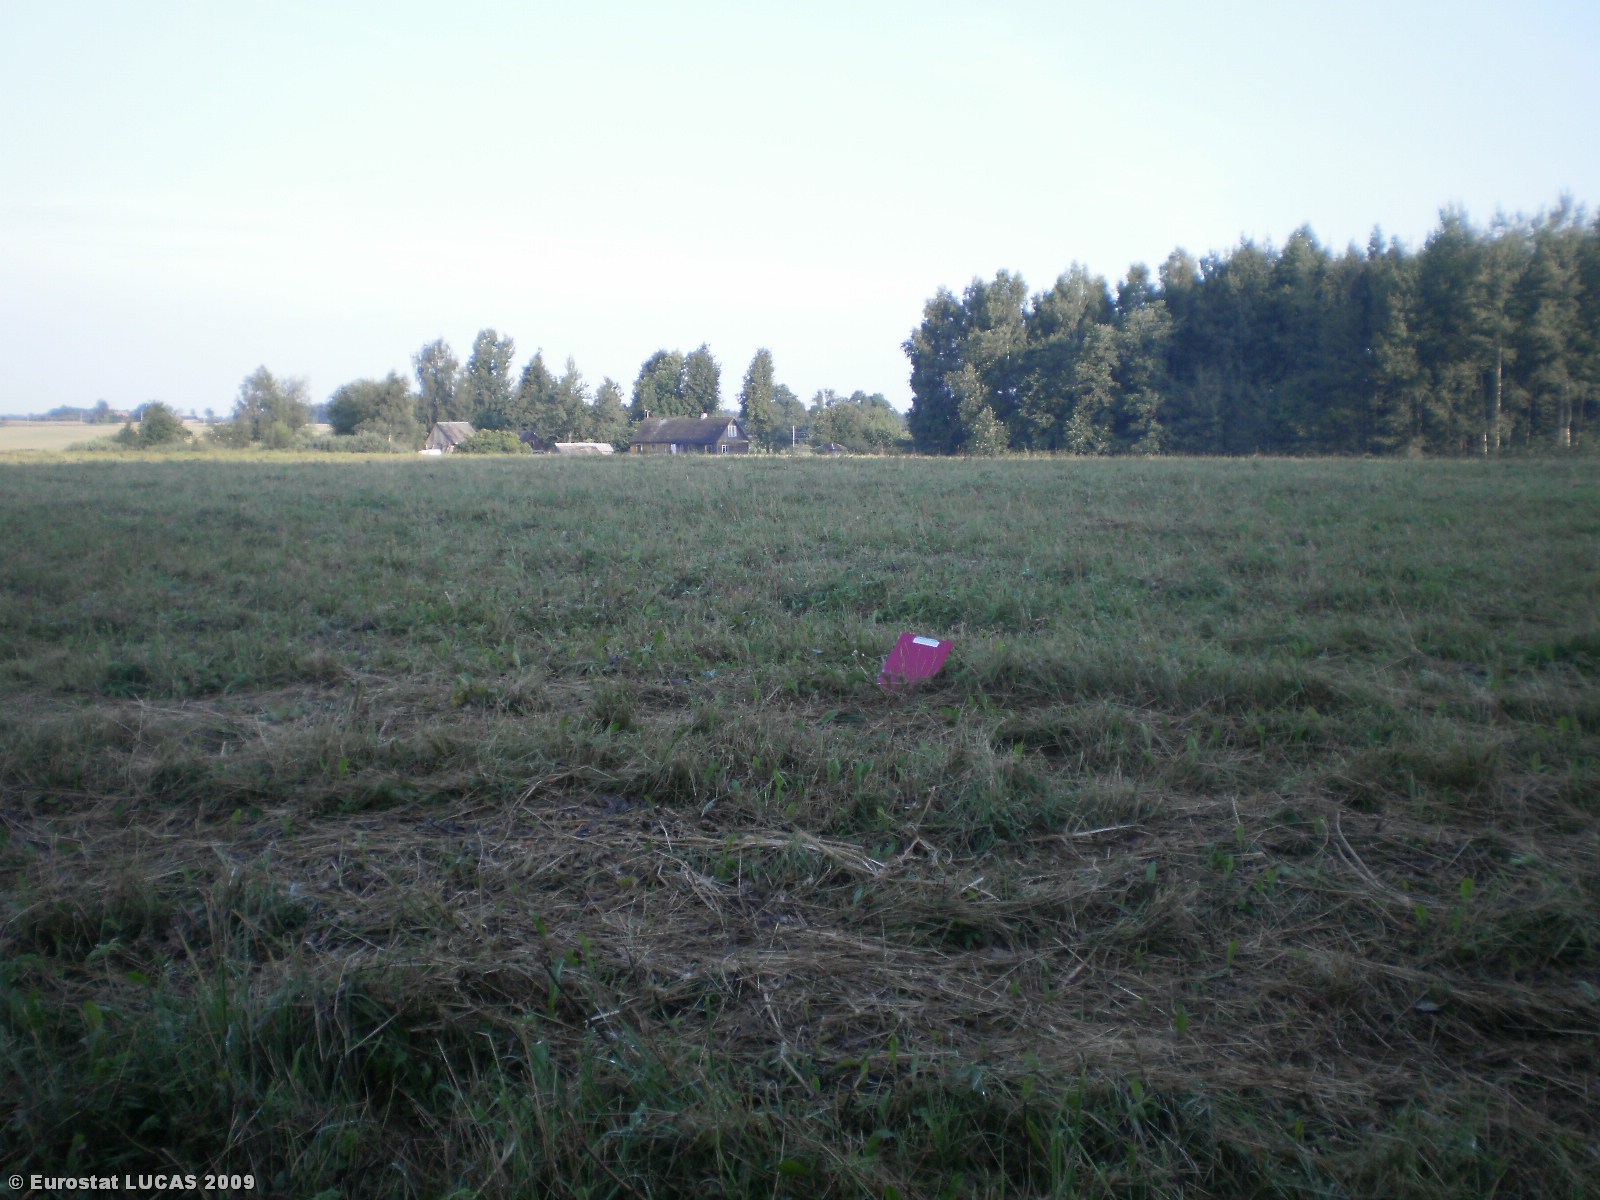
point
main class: Grassland
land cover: Grassland without tree/shrub cover
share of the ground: > 75 %
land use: Agriculture (excluding fallow land and kitchen gardens)
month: July
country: LT
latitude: 55.9011
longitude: 25.6241
